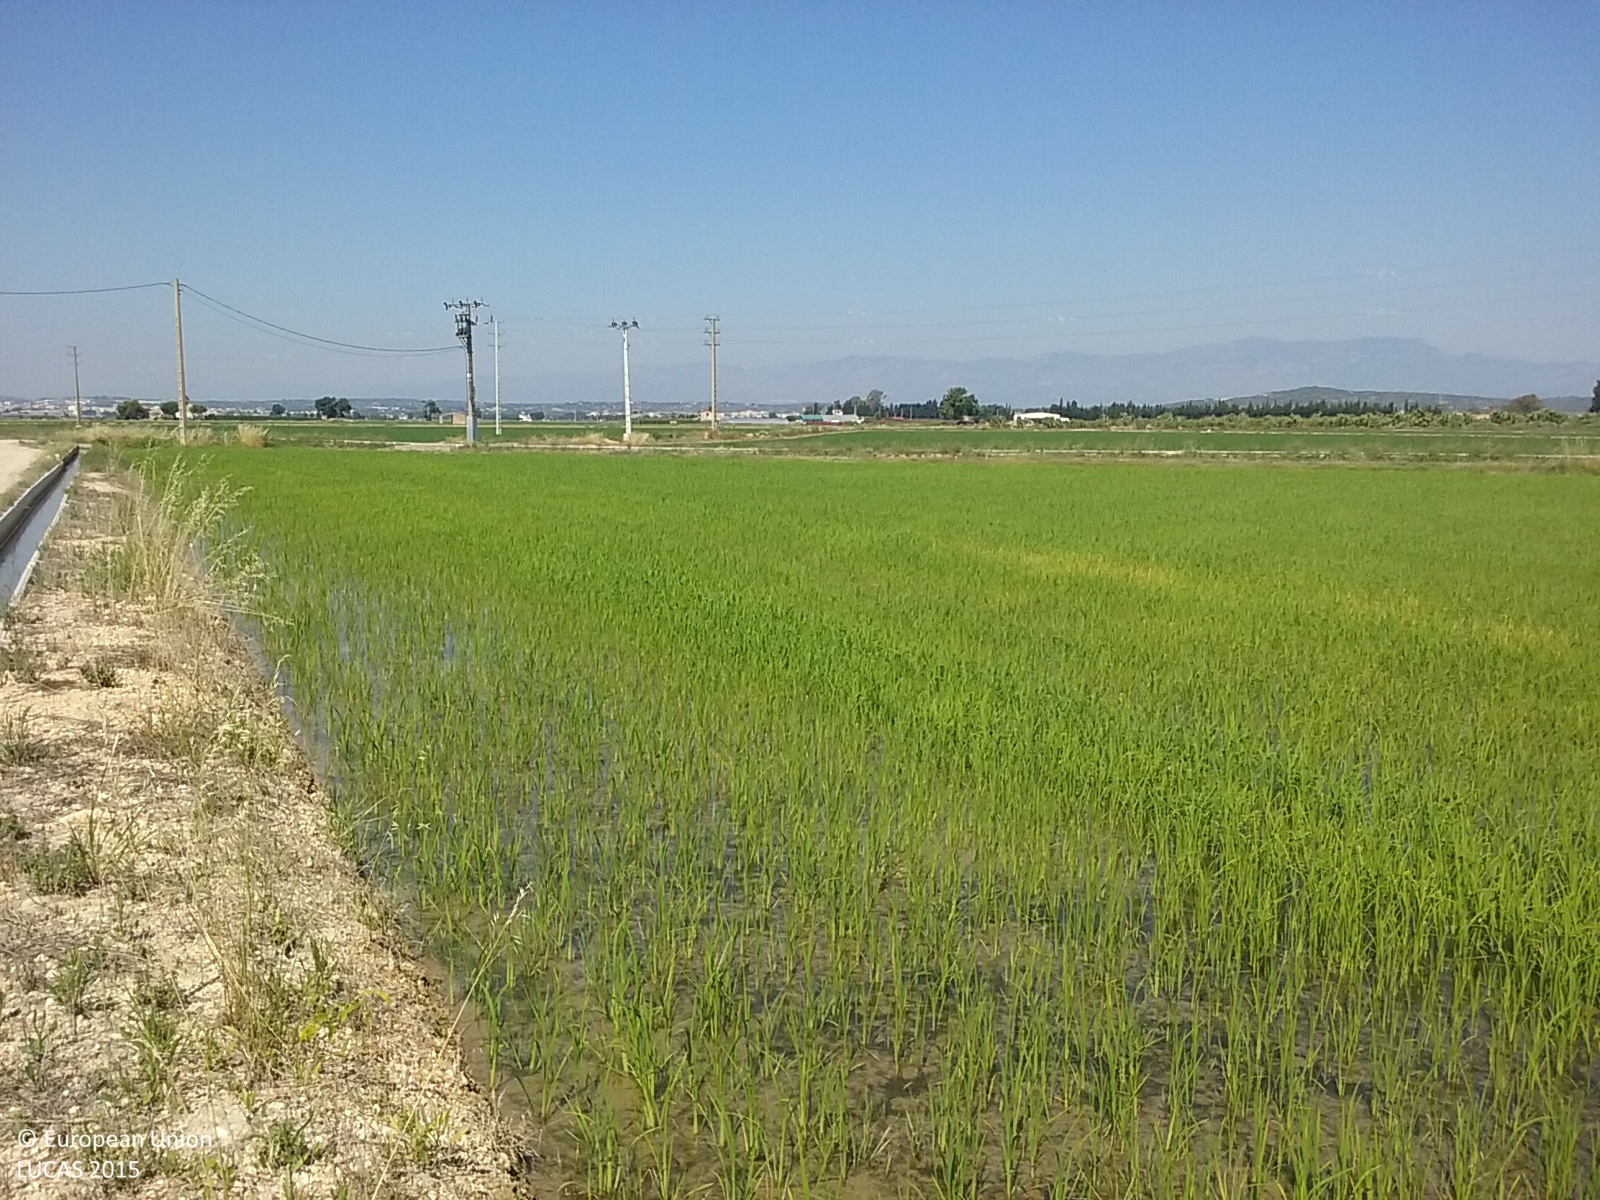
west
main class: Cropland
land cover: Rice
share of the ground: 50 - 75 %
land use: Agriculture (excluding fallow land and kitchen gardens)
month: June
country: ES
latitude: 40.7279
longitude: 0.6296
